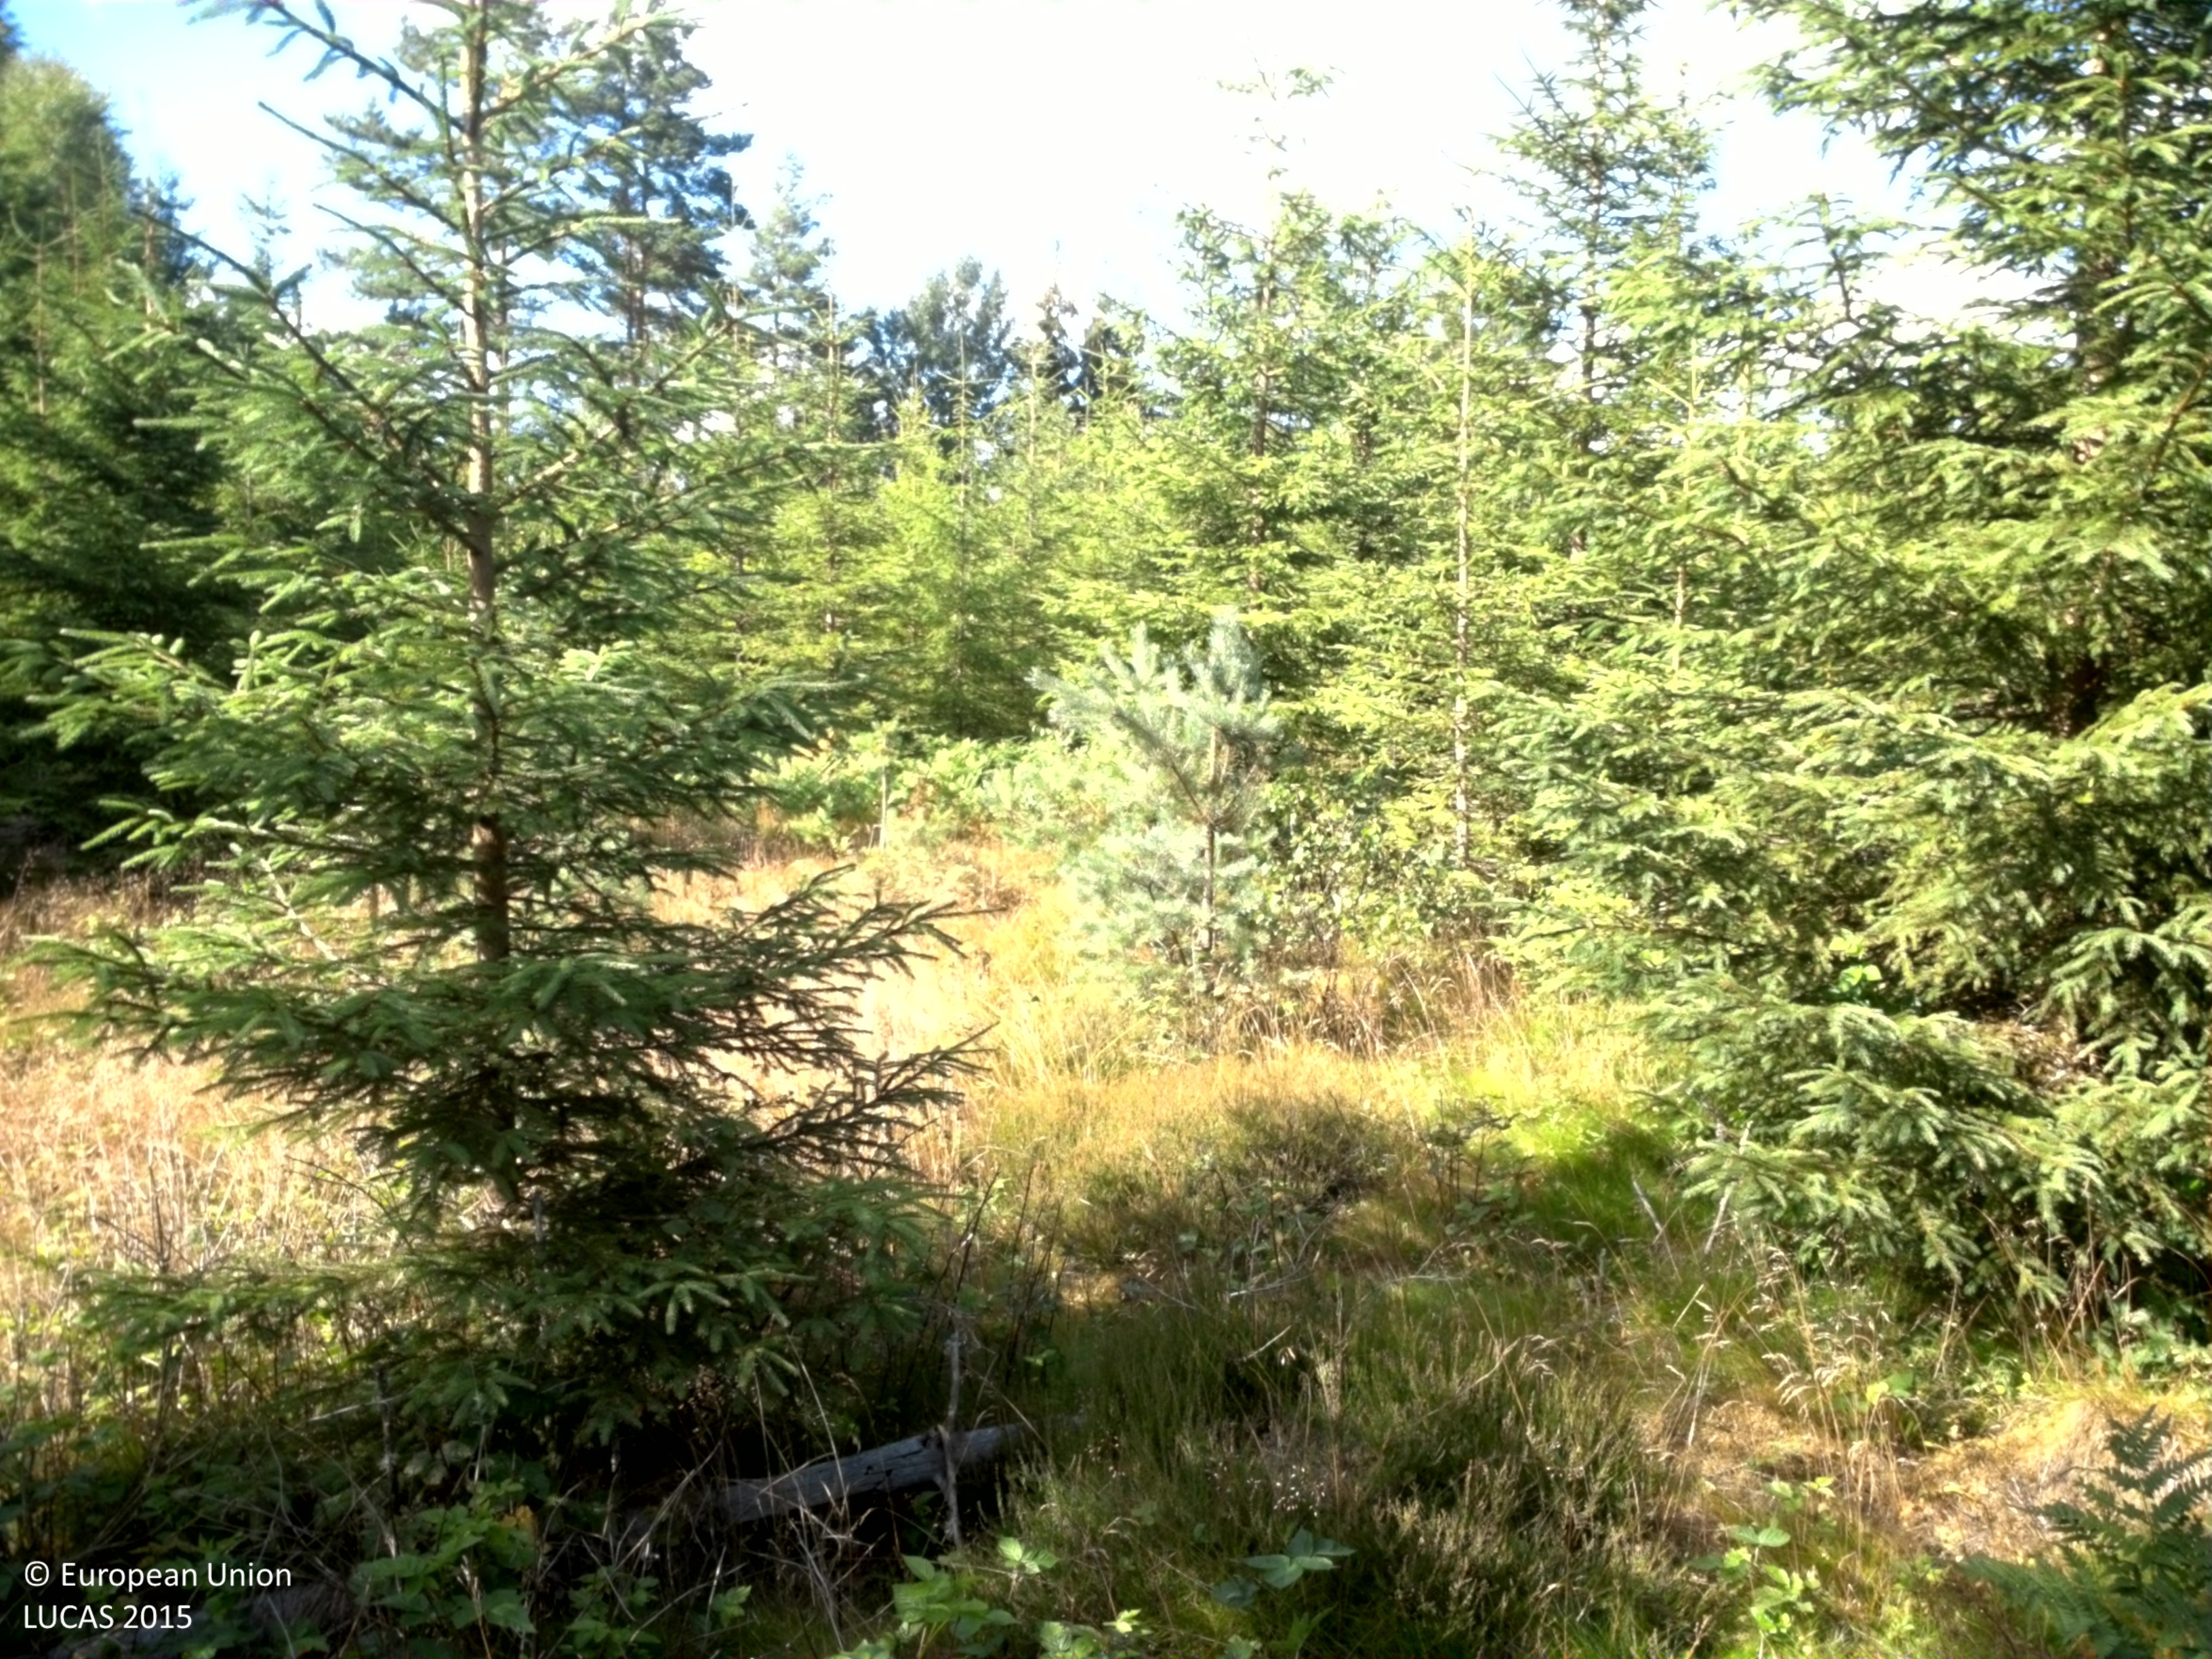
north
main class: Woodland
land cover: Spruce dominated coniferous woodland
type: boreal forest
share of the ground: 50 - 75 %
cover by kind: coniferous forest trees 50 %, lichens and mosses 30 %, herbaceous plants 20 %
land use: Forestry
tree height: < 5 m
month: August
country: SE
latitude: 58.1065
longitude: 13.9822
